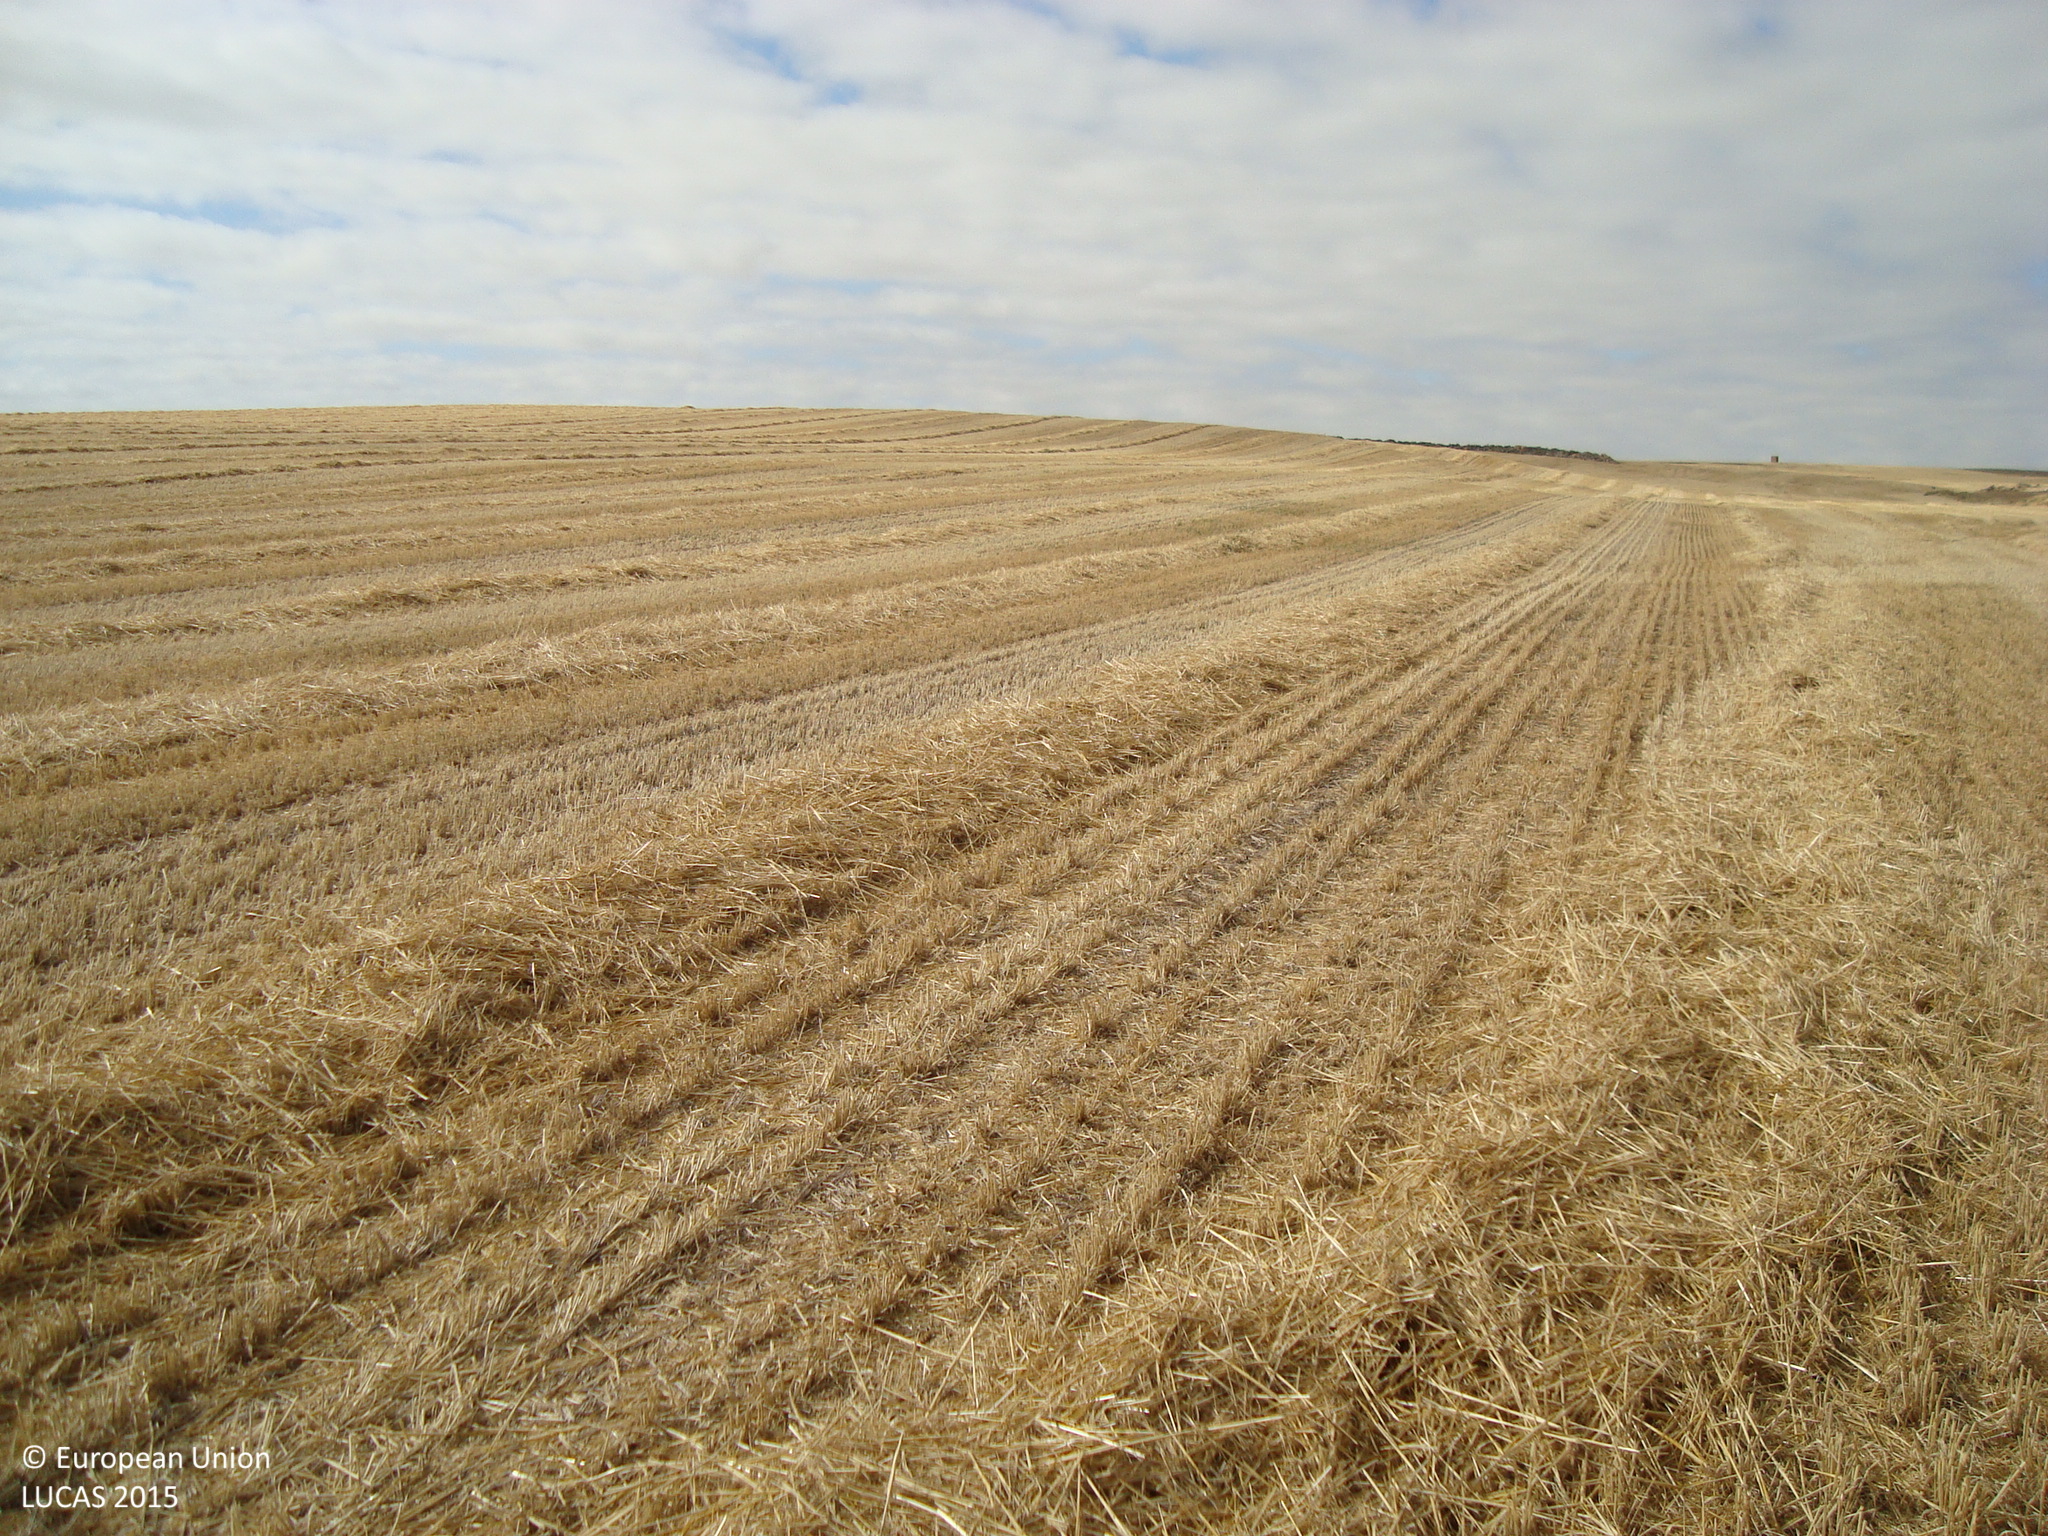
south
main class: Cropland
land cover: Common wheat
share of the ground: > 75 %
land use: Agriculture (excluding fallow land and kitchen gardens)
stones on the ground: < 10 %
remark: Harvested field
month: July
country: ES
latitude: 42.0004
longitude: -3.9074
